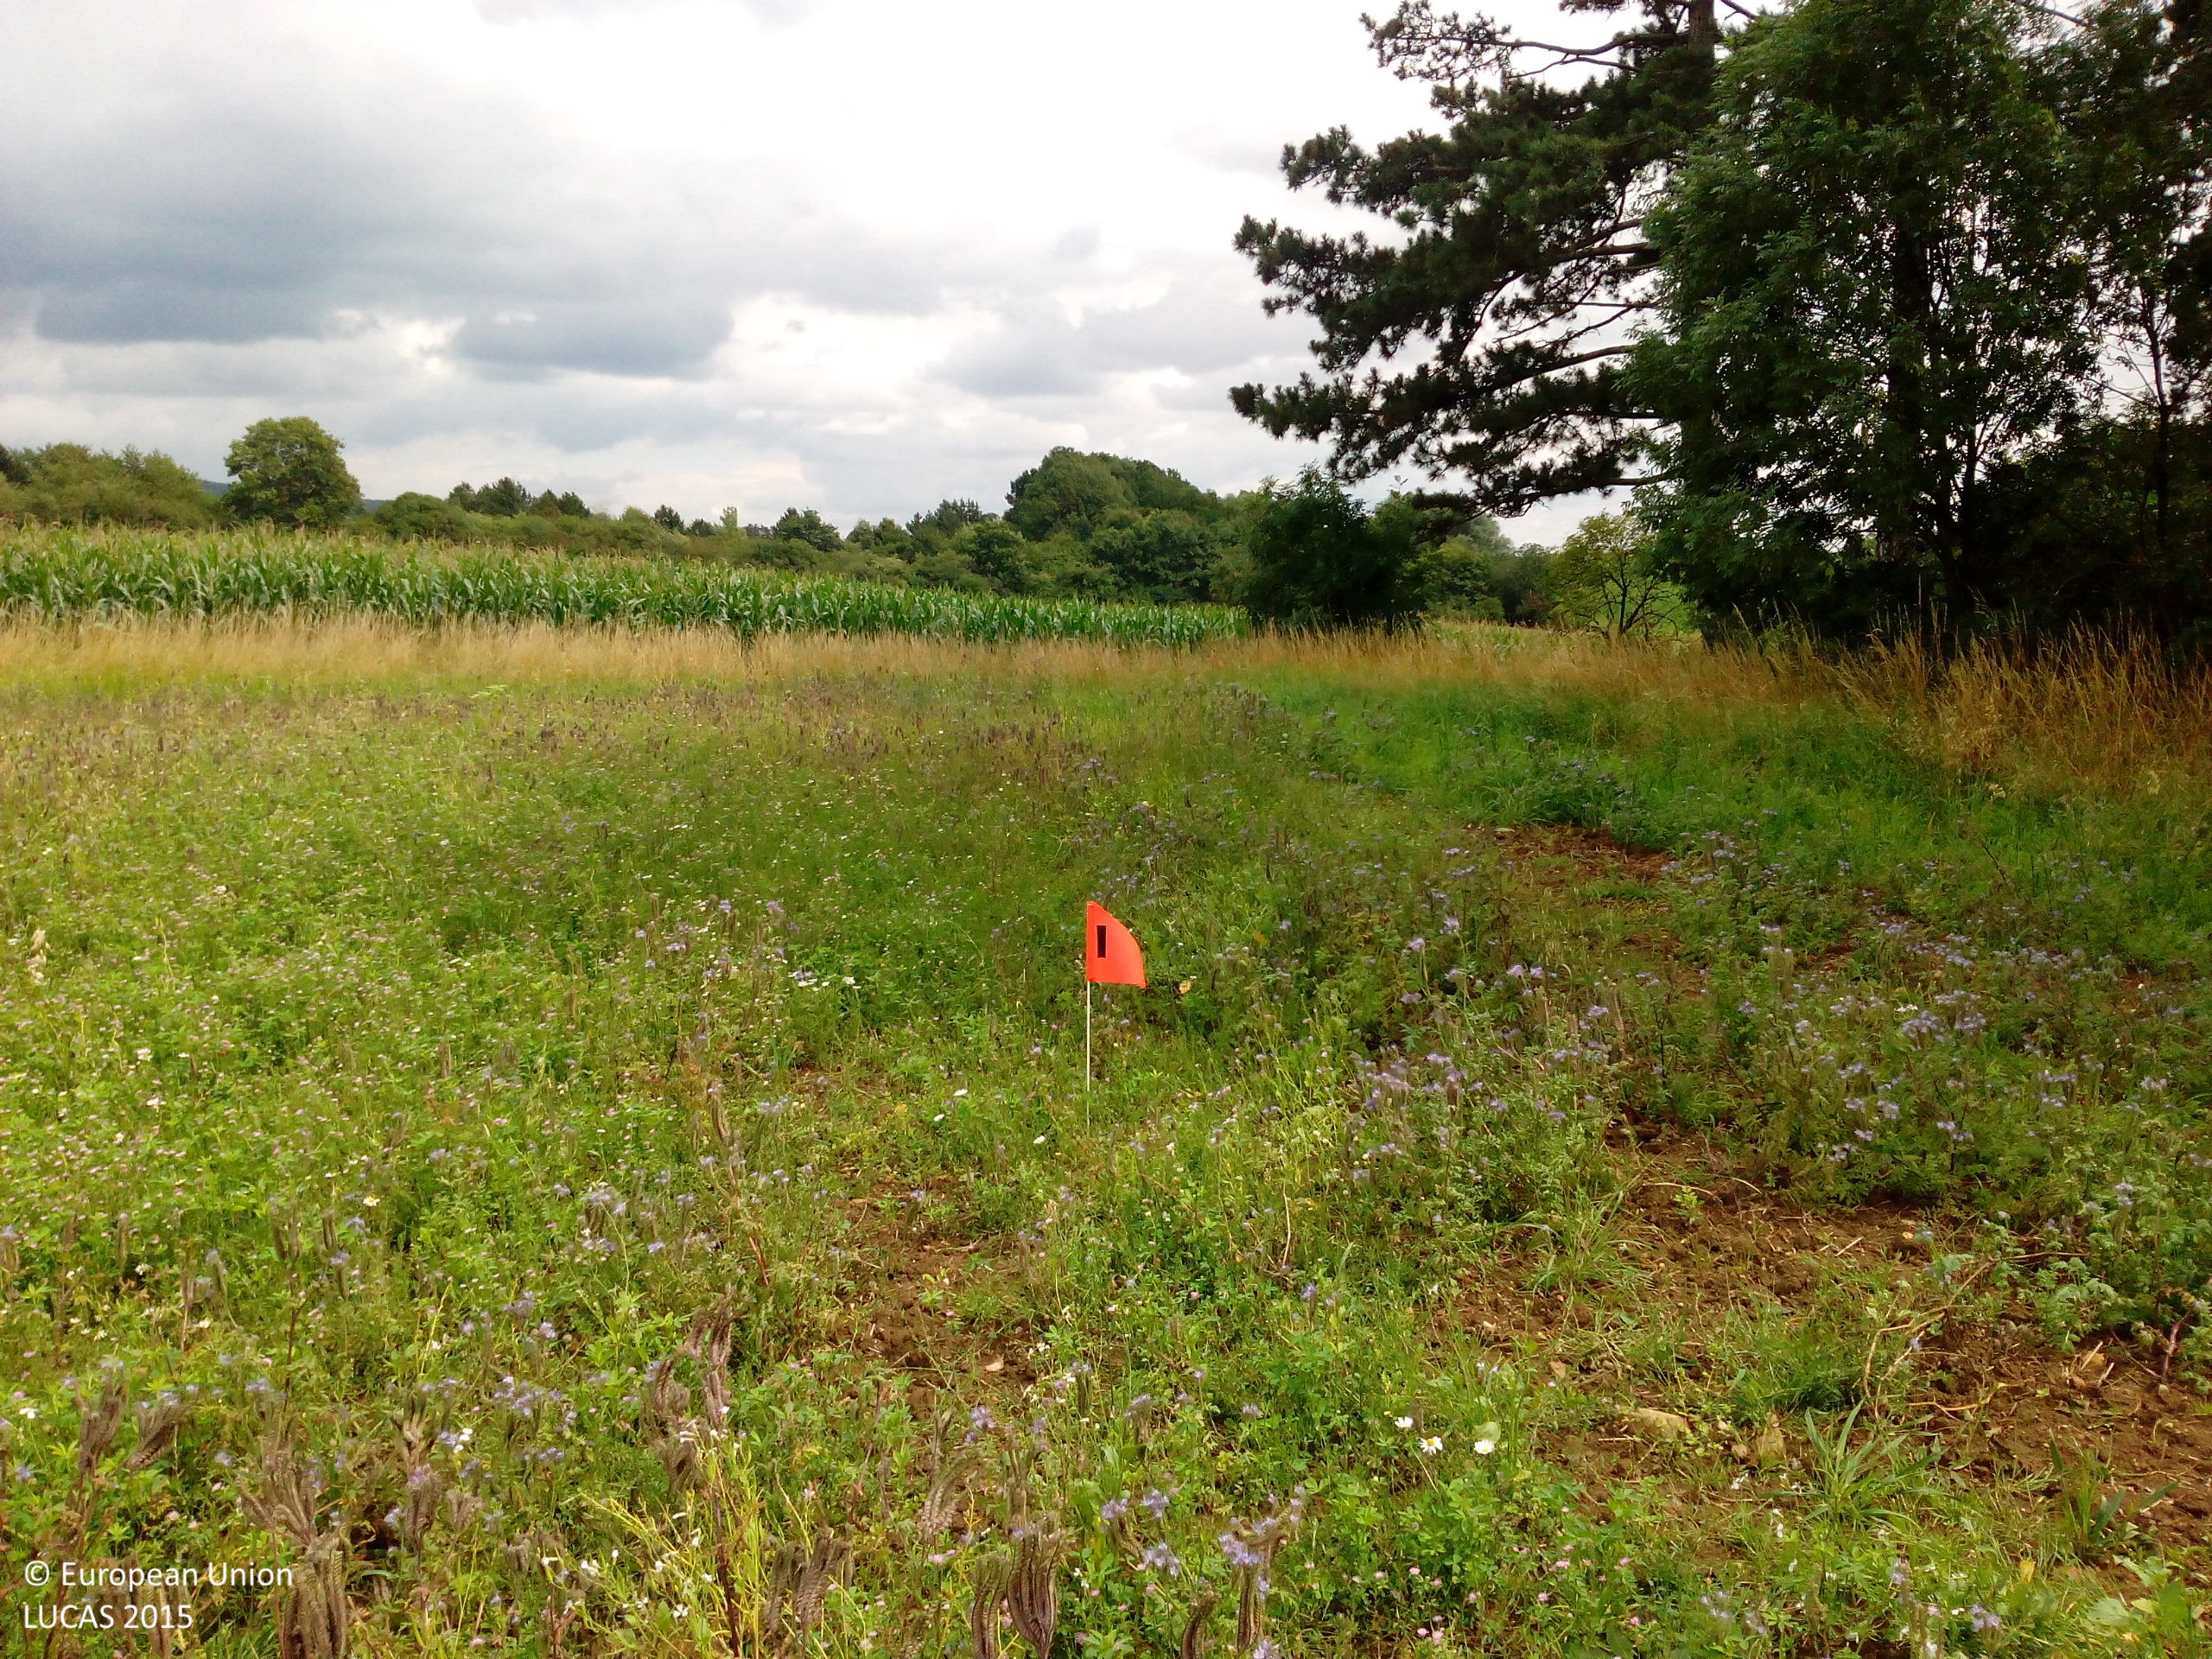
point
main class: Cropland
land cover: Other leguminous and mixtures for fodder
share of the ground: > 75 %
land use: Agriculture (excluding fallow land and kitchen gardens)
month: July
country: DE
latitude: 52.1957
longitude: 10.6874
